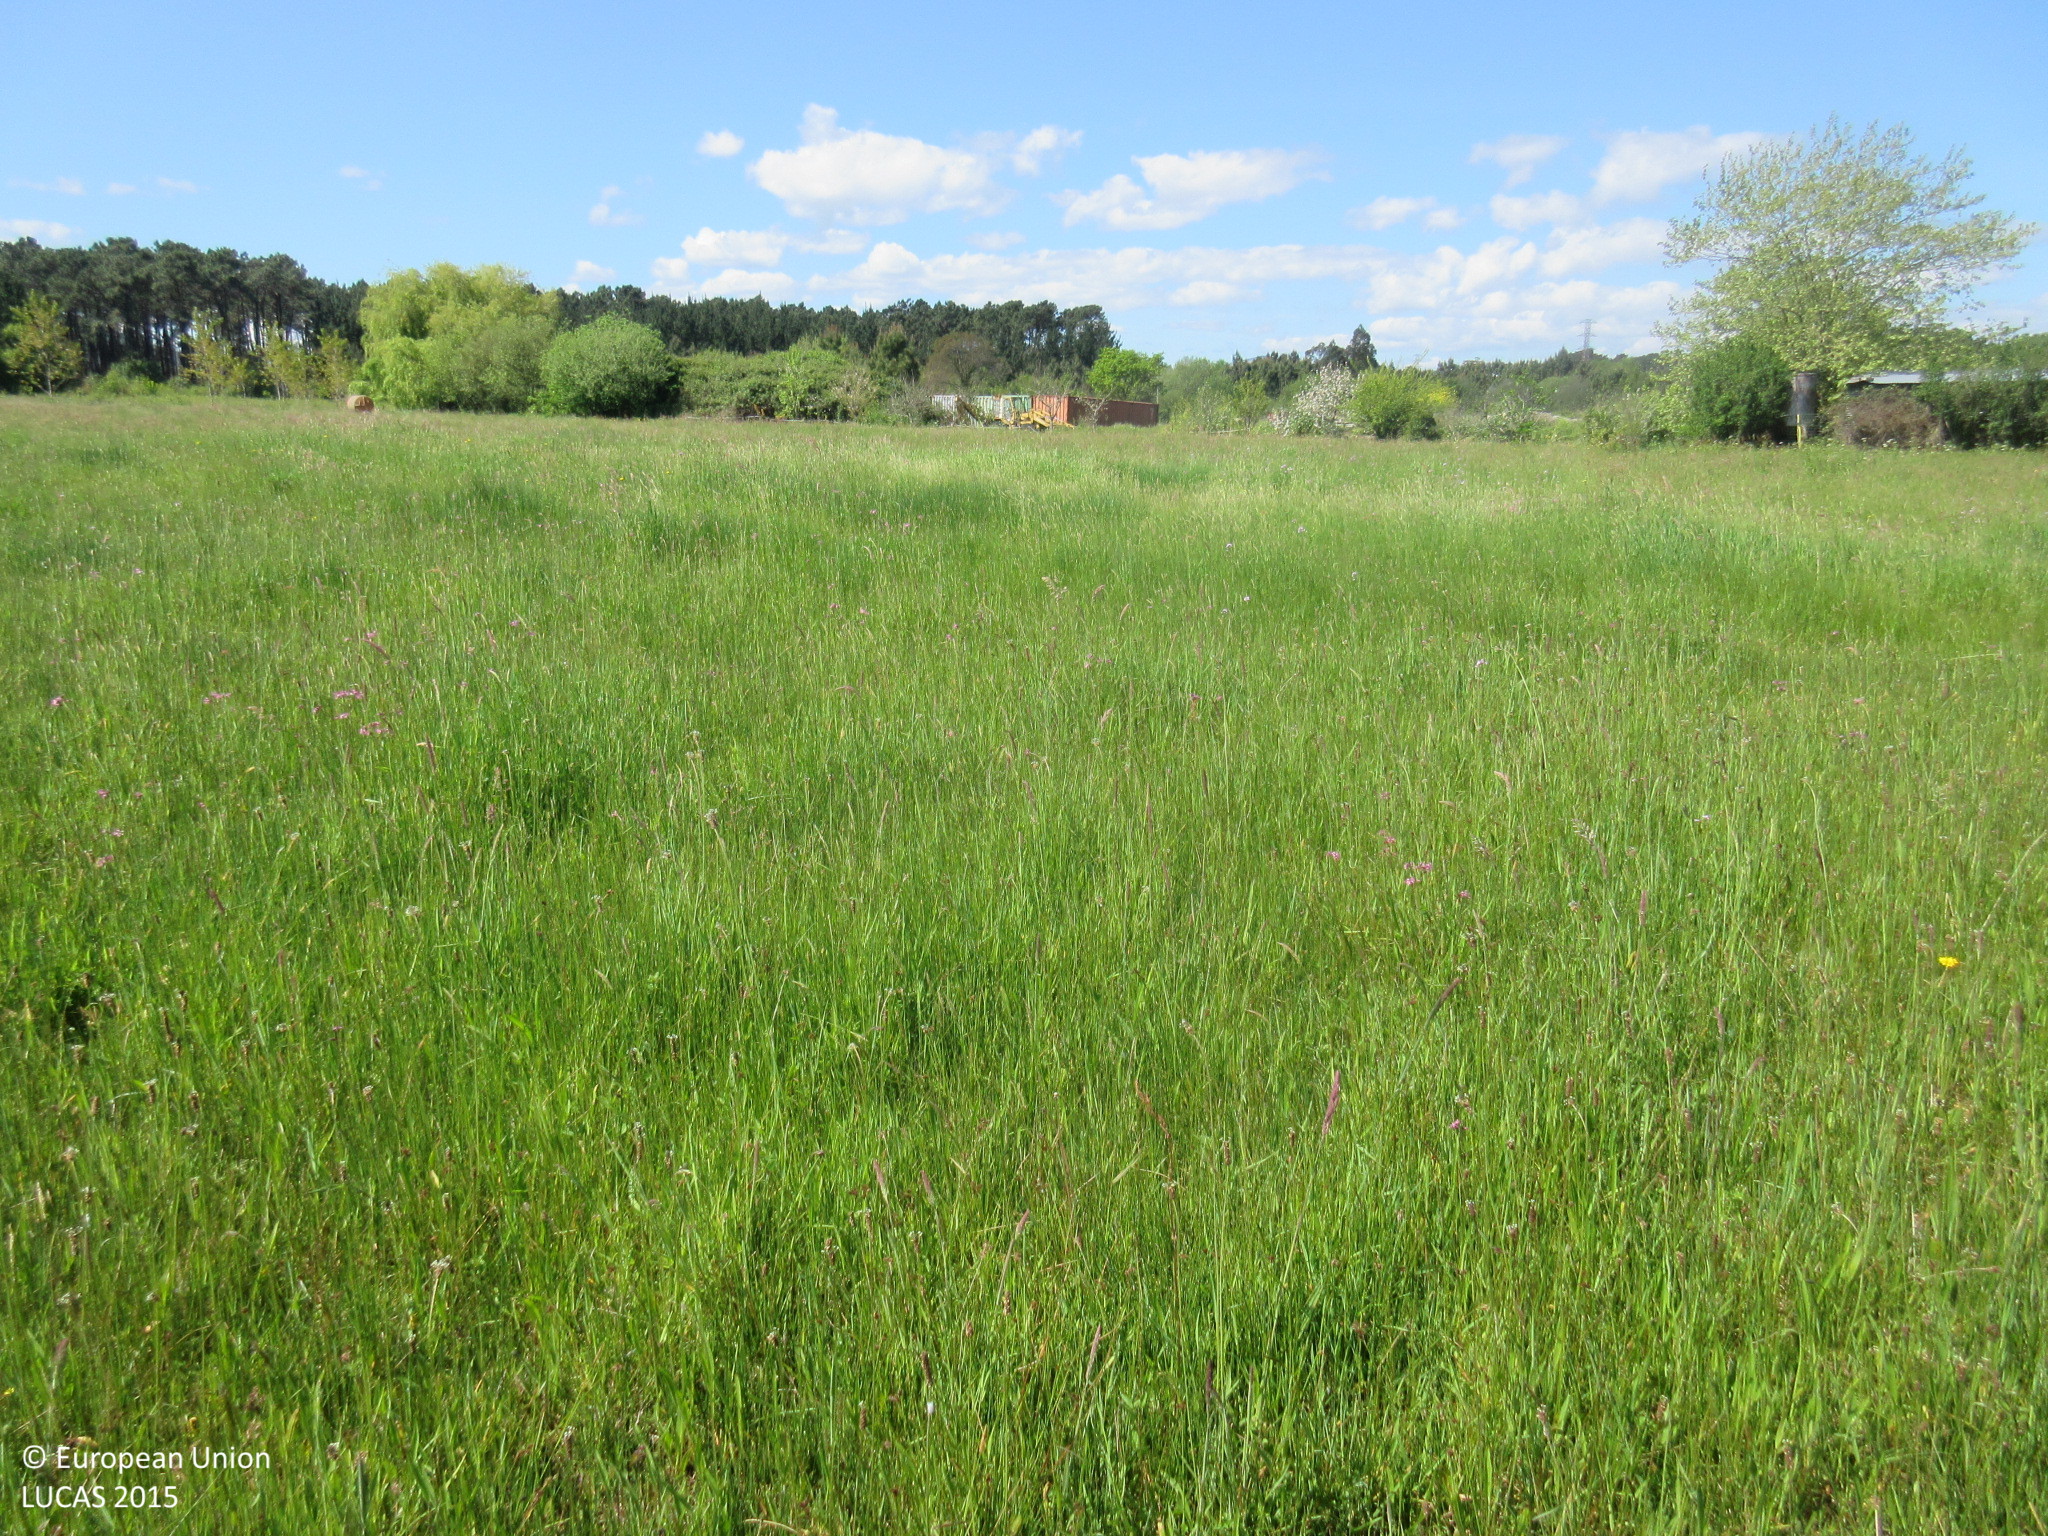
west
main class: Grassland
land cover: Grassland without tree/shrub cover
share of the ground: > 75 %
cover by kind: herbaceous plants 100 %
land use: Agriculture (excluding fallow land and kitchen gardens)
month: April
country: ES
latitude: 43.5272
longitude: -6.9817
